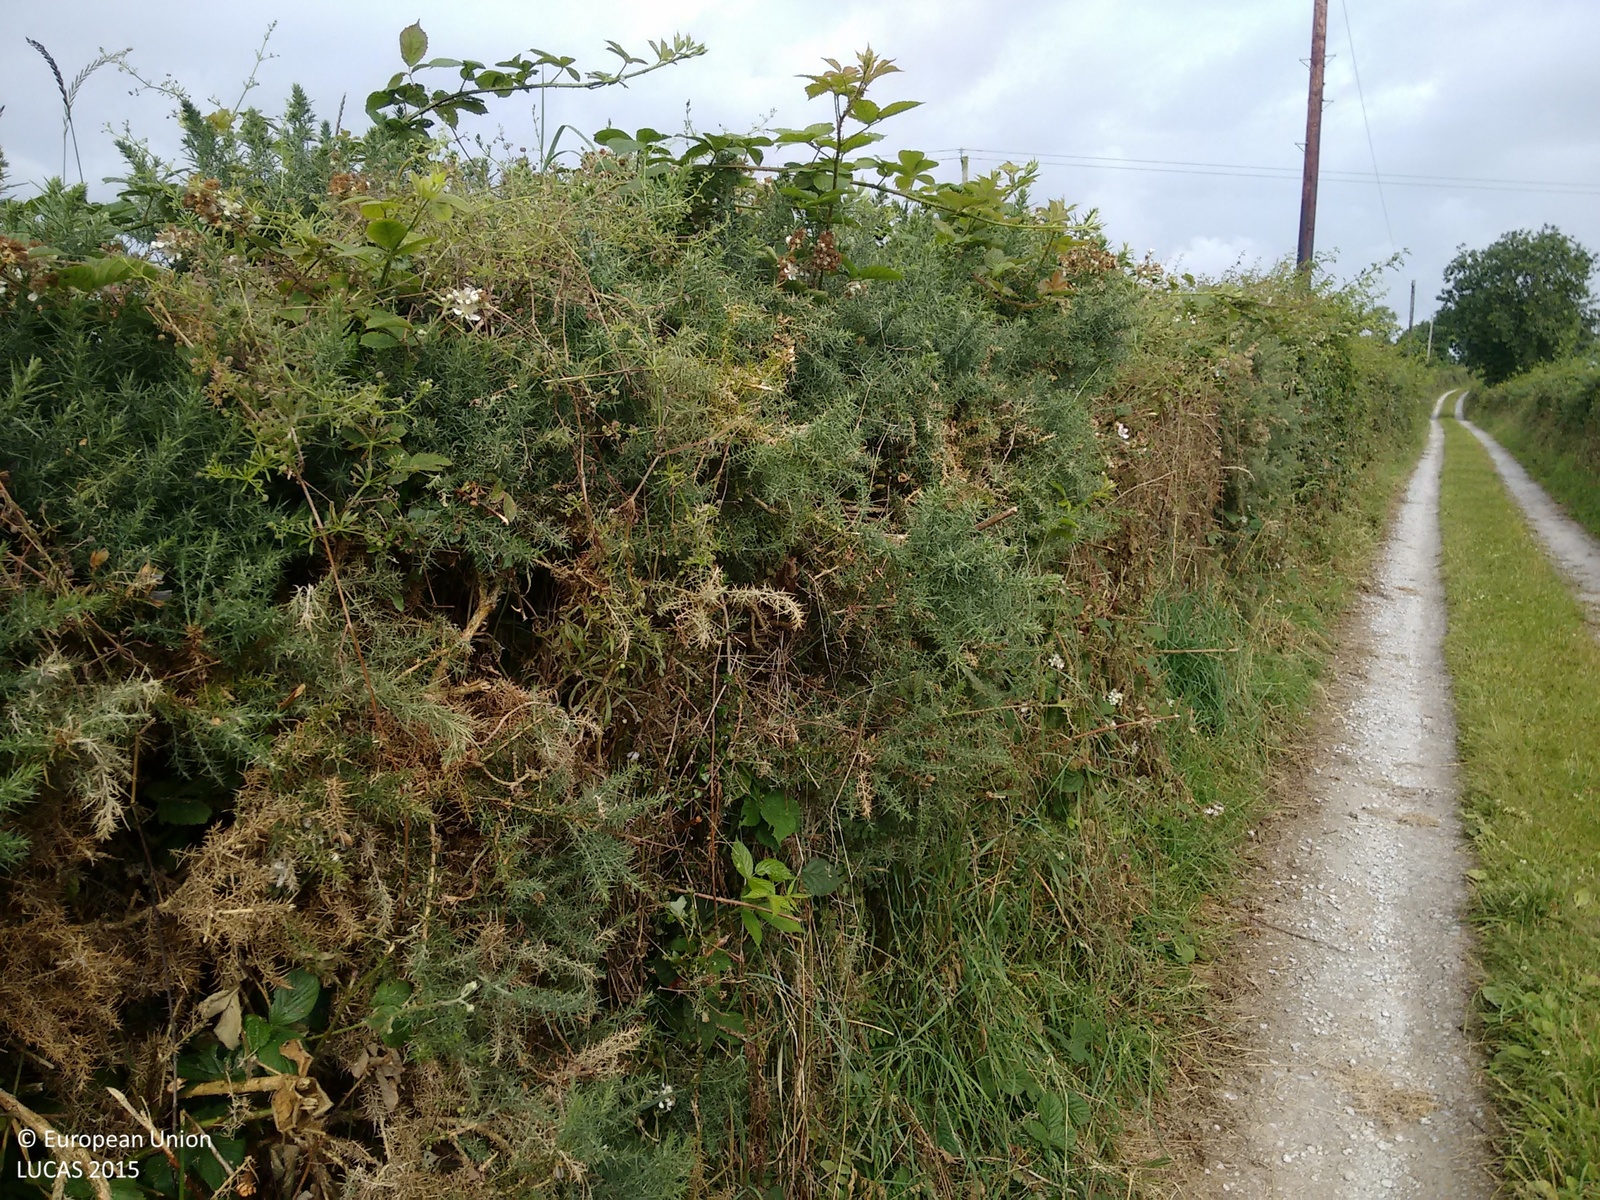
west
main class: Cropland
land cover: Oats
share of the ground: > 75 %
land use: Agriculture (excluding fallow land and kitchen gardens)
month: July
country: IE
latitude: 52.1247
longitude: -8.9513
